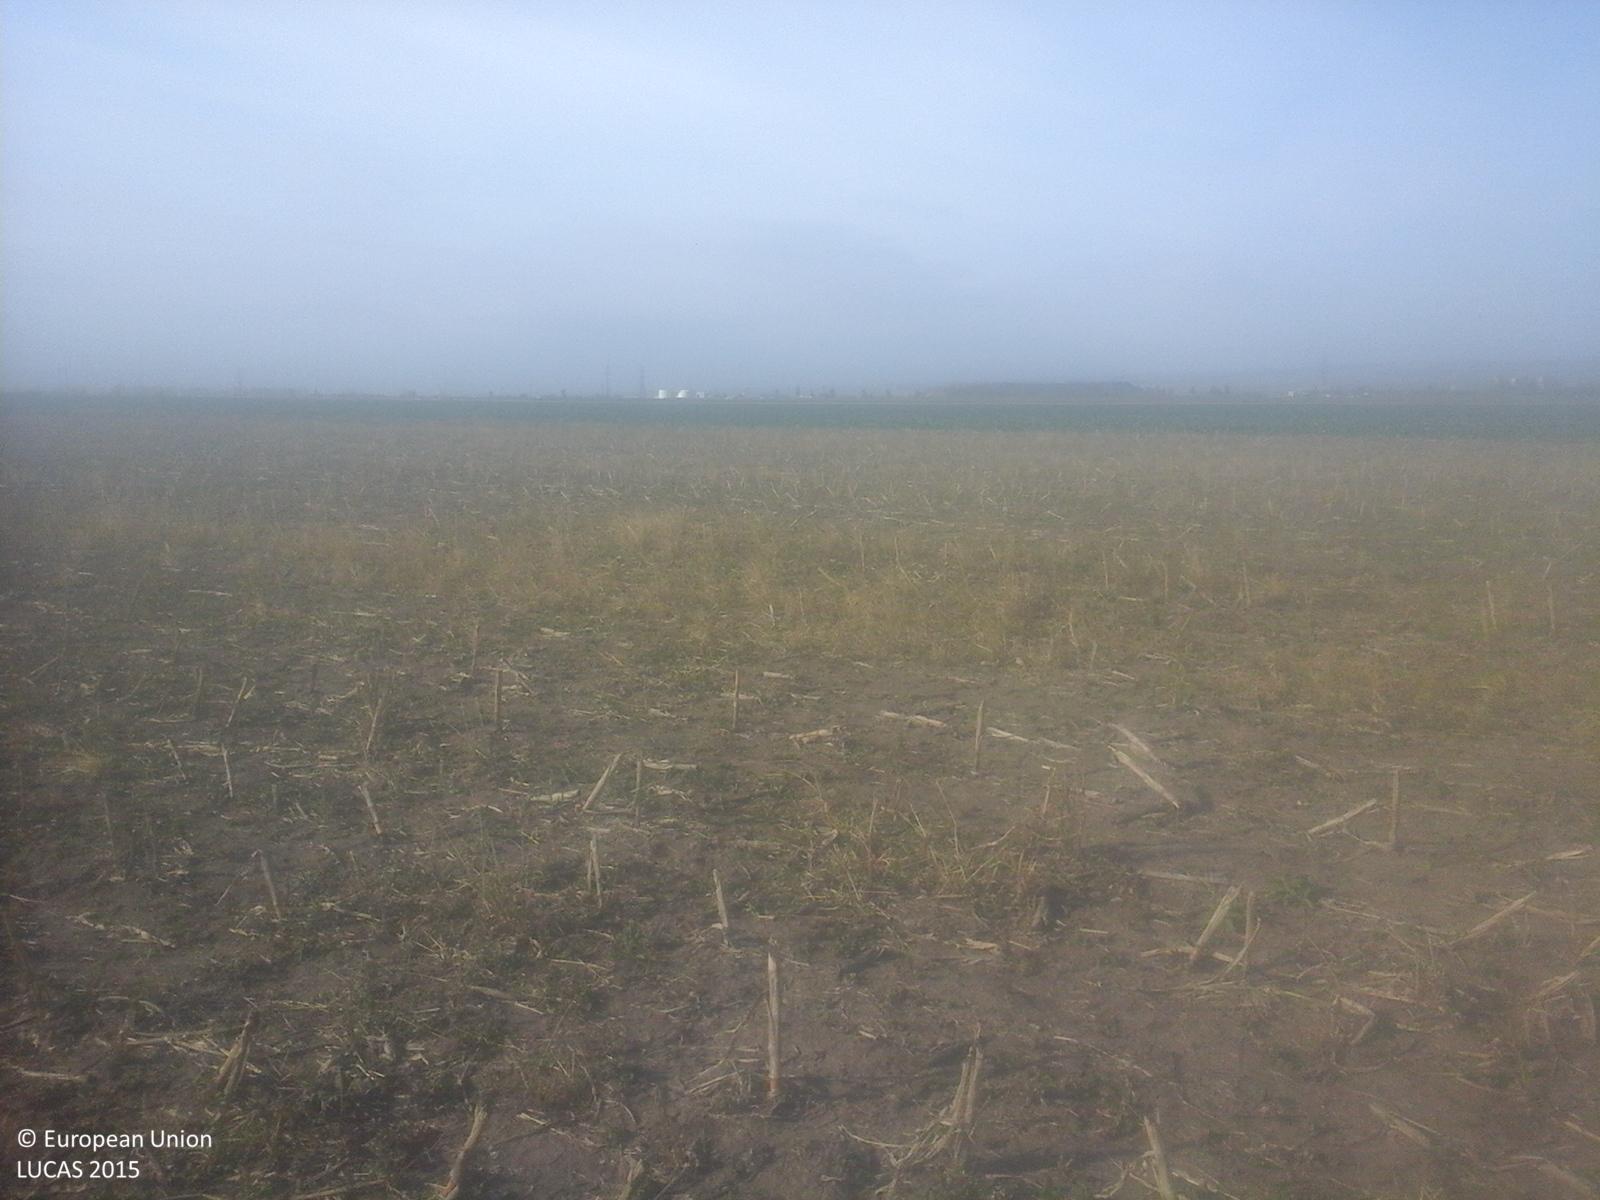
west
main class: Cropland
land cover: Maize
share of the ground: 10 - 25 %
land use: Agriculture (excluding fallow land and kitchen gardens)
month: October
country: RO
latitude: 45.3685
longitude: 27.0832
